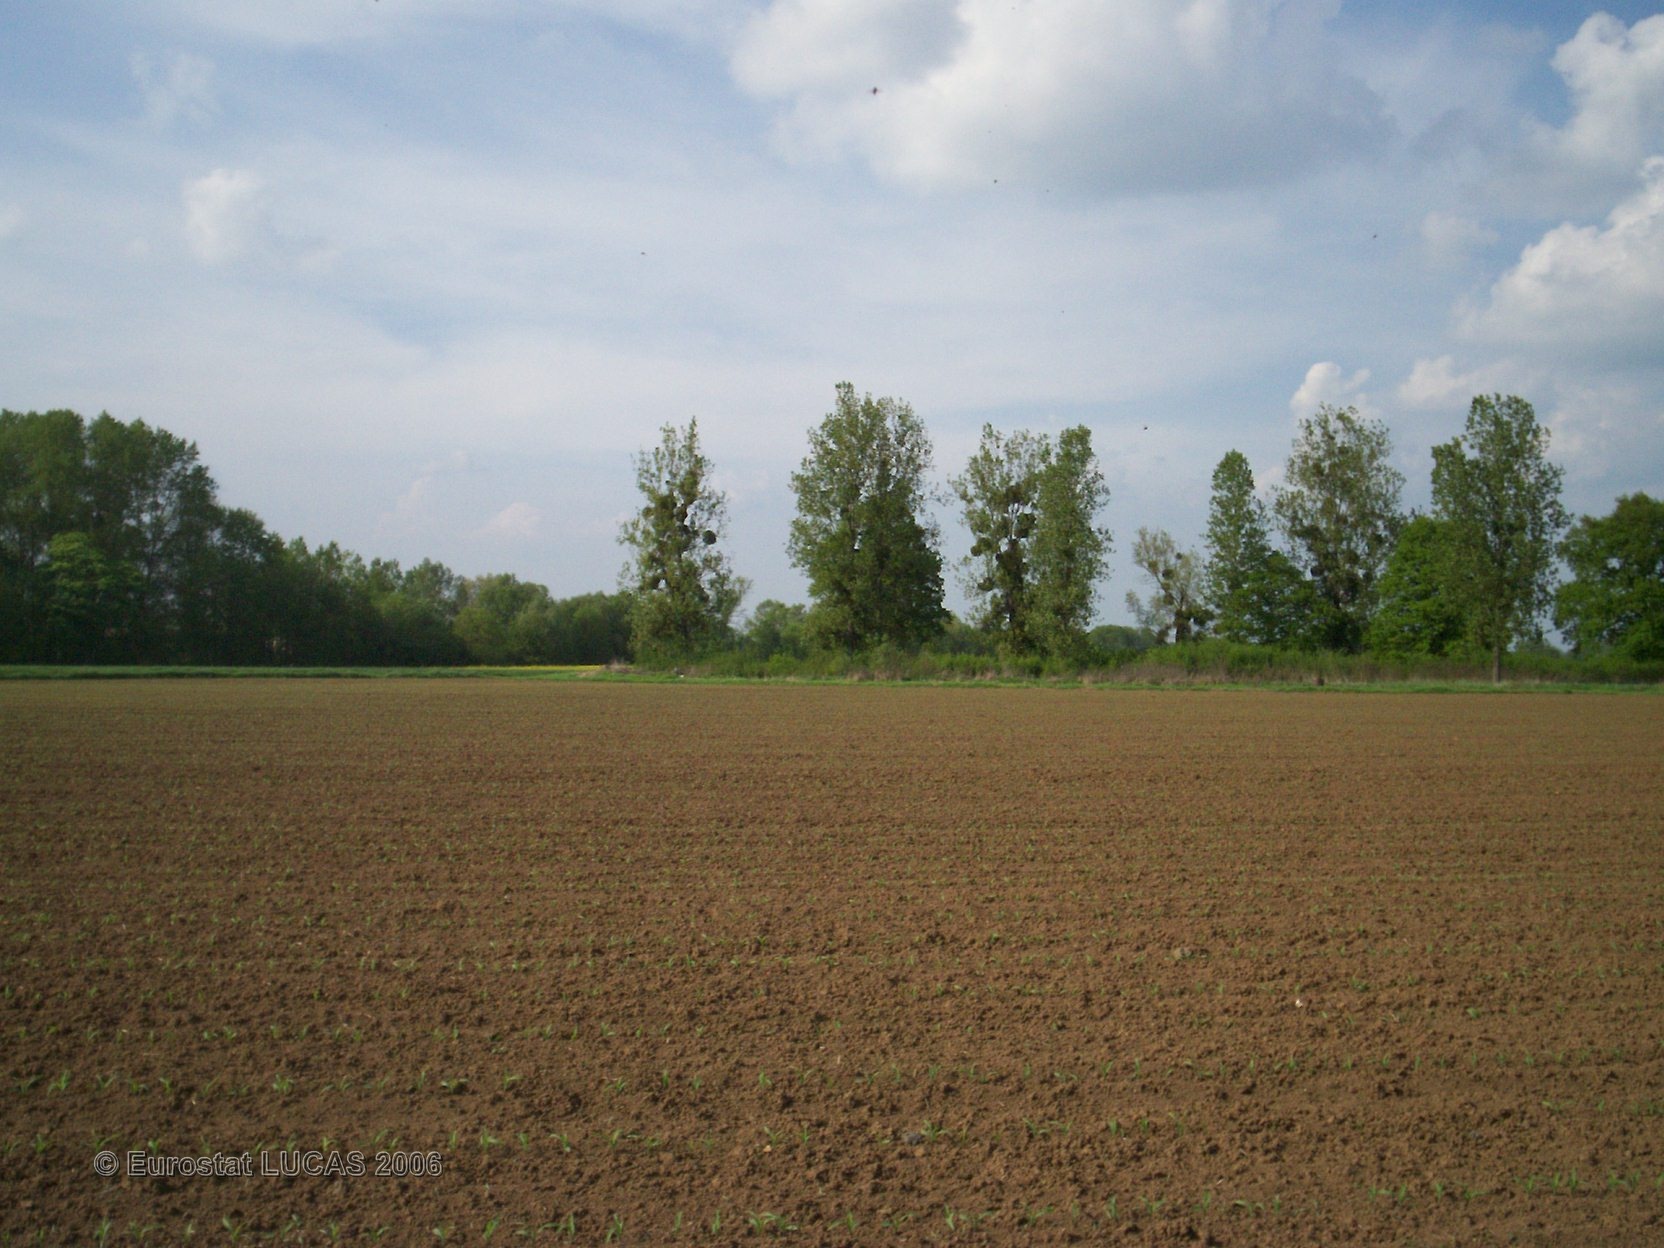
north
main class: Cropland
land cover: Maize
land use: Agriculture (excluding fallow land and kitchen gardens)
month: May
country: FR
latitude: 49.5915
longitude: 4.3099
